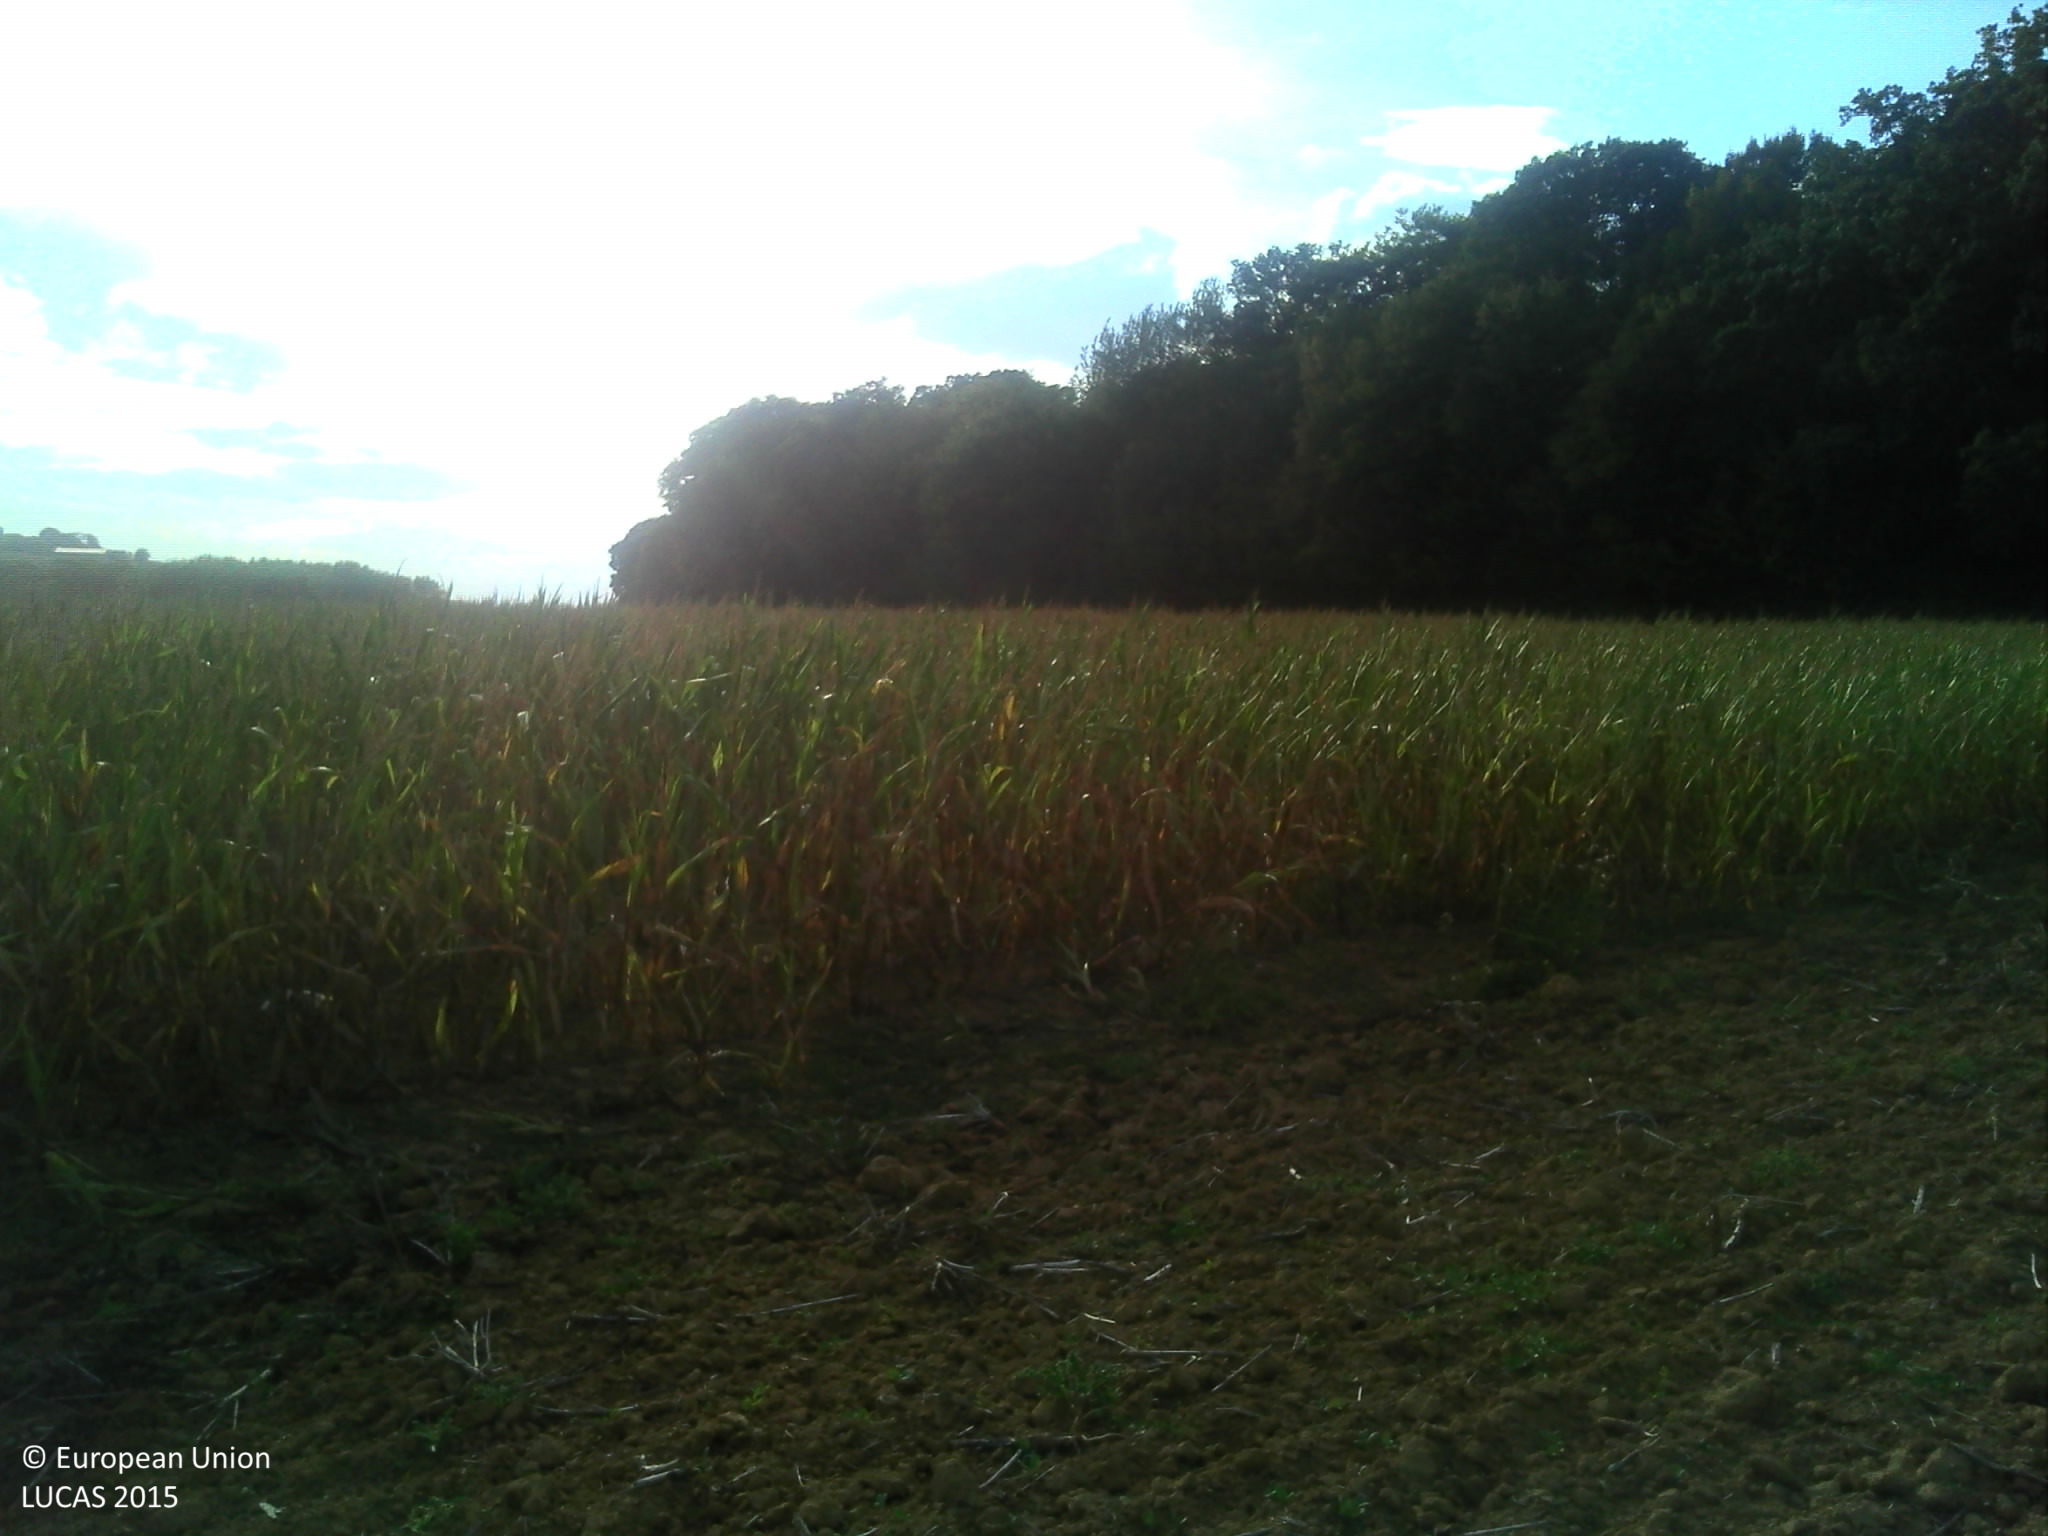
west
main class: Cropland
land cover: Rape and turnip rape
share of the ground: < 10 %
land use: Agriculture (excluding fallow land and kitchen gardens)
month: August
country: FR
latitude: 48.8765
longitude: 6.1411
